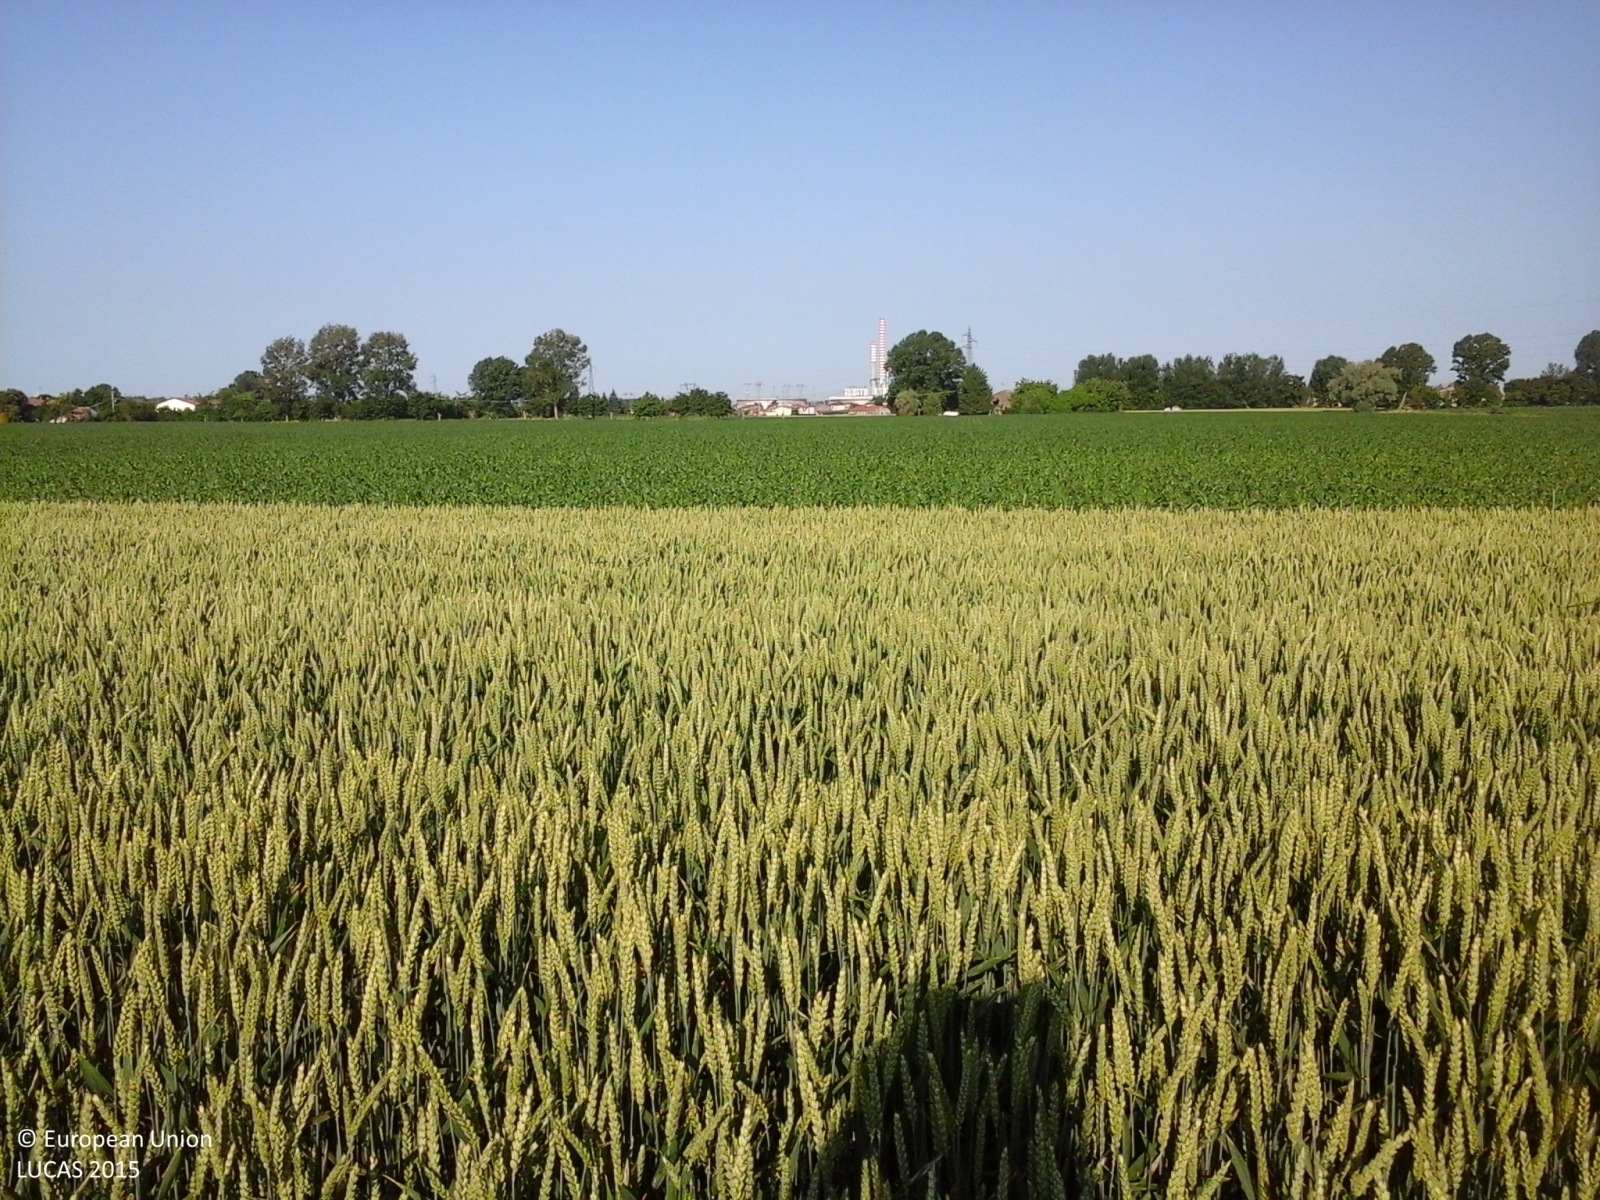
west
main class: Cropland
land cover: Common wheat
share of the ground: > 75 %
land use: Agriculture (excluding fallow land and kitchen gardens)
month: May
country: IT
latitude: 45.0652
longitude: 11.1789
